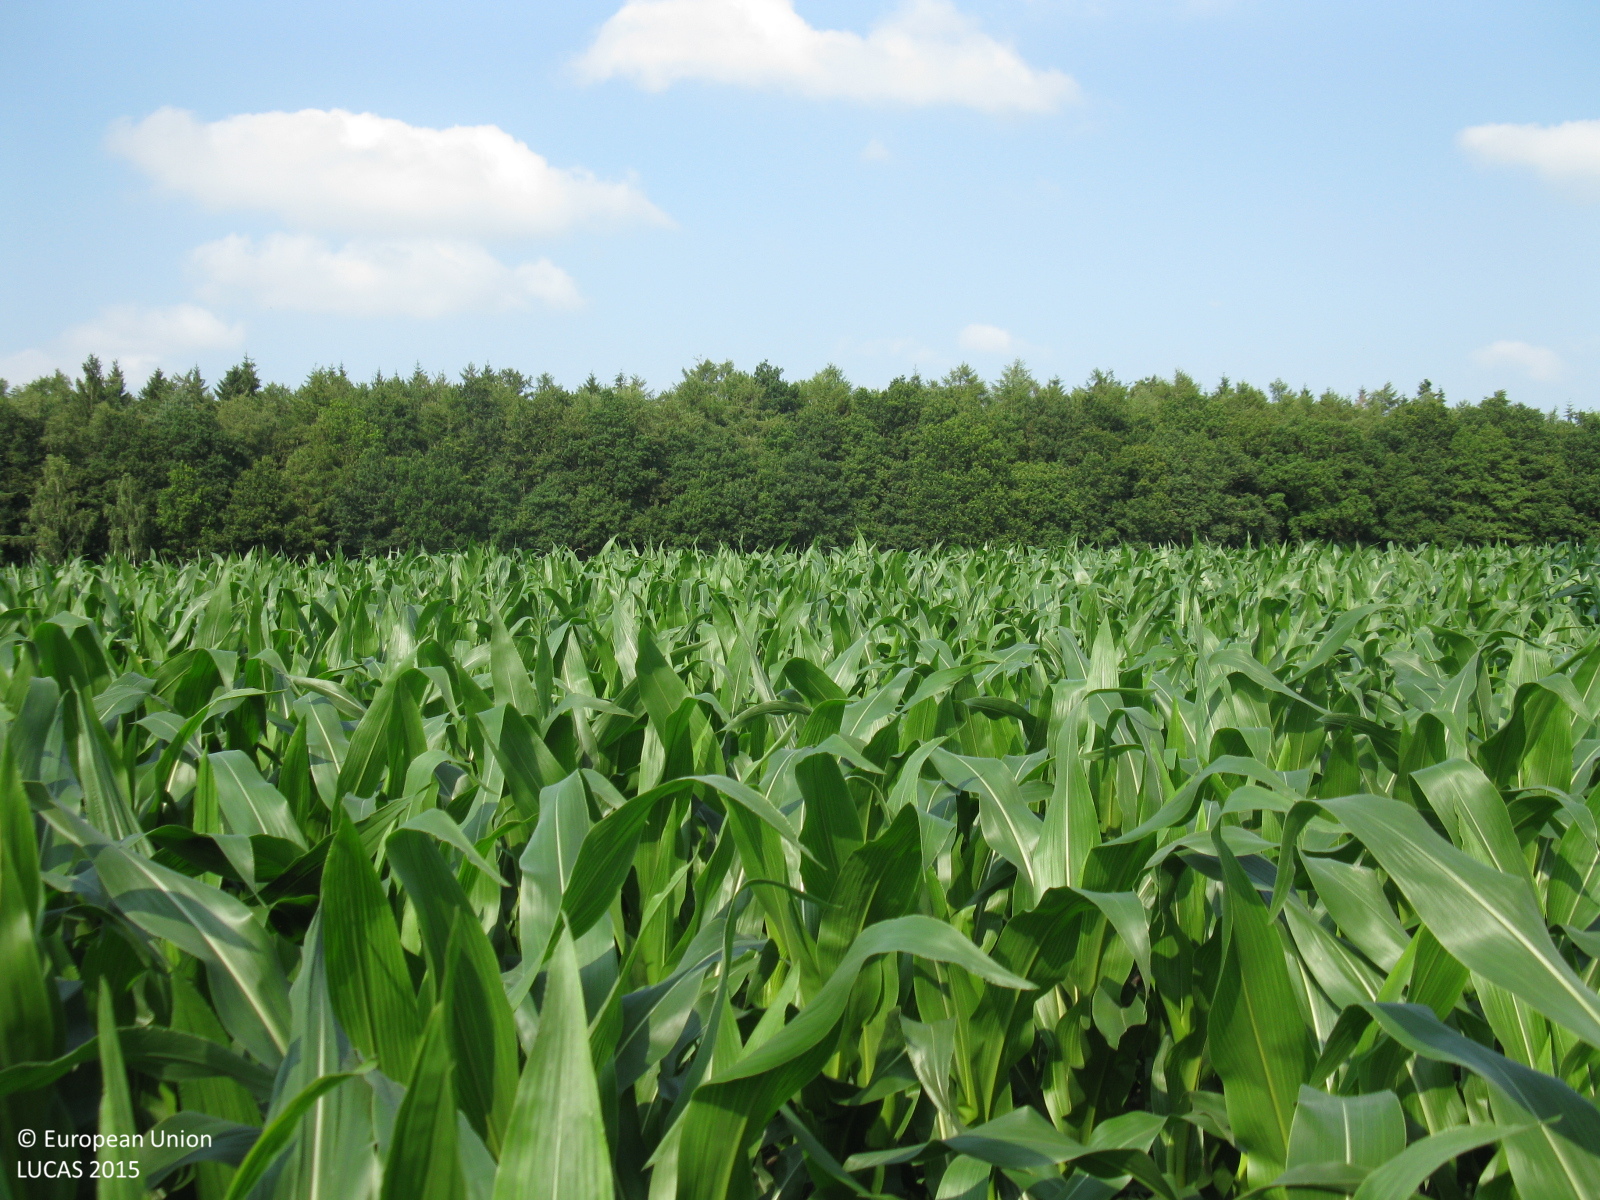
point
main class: Cropland
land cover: Maize
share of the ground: > 75 %
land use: Agriculture (excluding fallow land and kitchen gardens)
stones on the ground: < 10 %
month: July
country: DE
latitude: 53.2043
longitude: 7.9196
